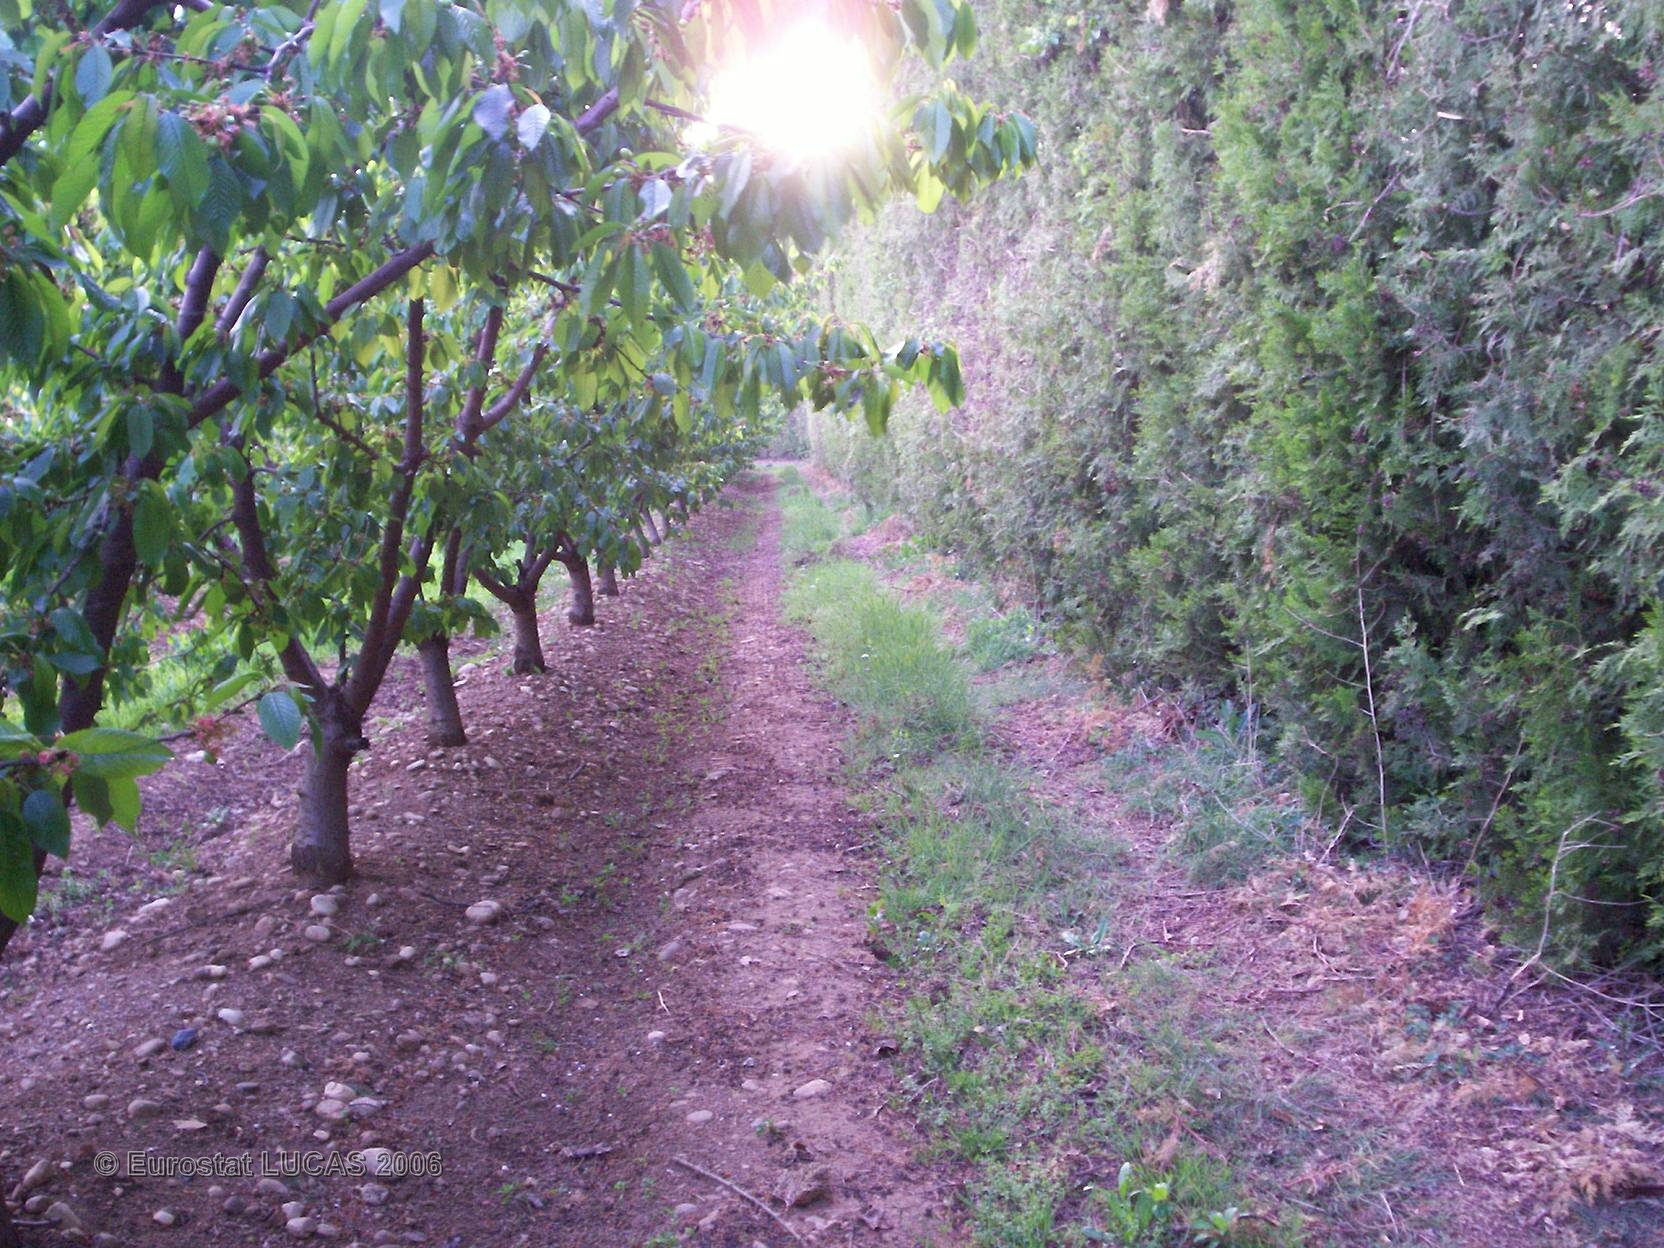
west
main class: Cropland
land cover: Cherry fruit
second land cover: Grassland with sparse tree/shrub cover
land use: Agriculture (excluding fallow land and kitchen gardens)
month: April
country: FR
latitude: 43.6500
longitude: 4.9634
